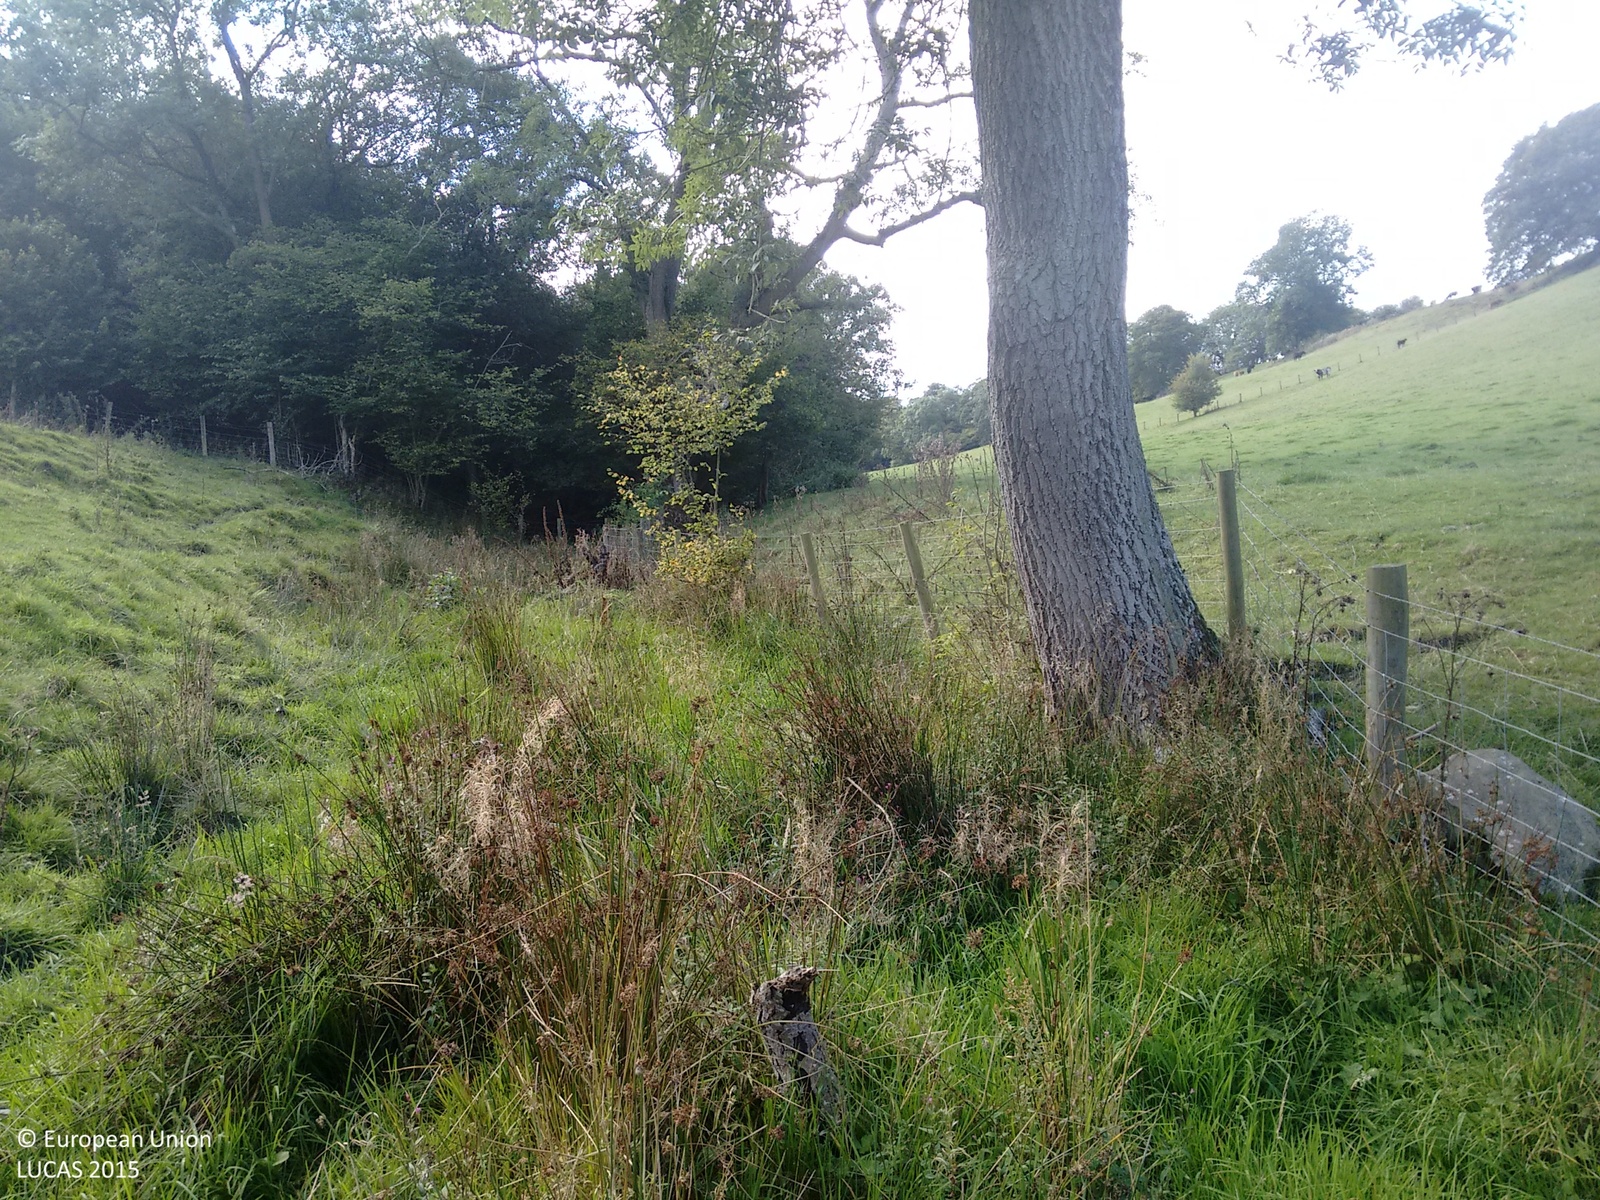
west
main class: Grassland
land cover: Grassland without tree/shrub cover
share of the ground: > 75 %
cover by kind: herbaceous plants 100 %
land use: Agriculture (excluding fallow land and kitchen gardens)
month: September
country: GB
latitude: 52.5952
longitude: -3.2629
